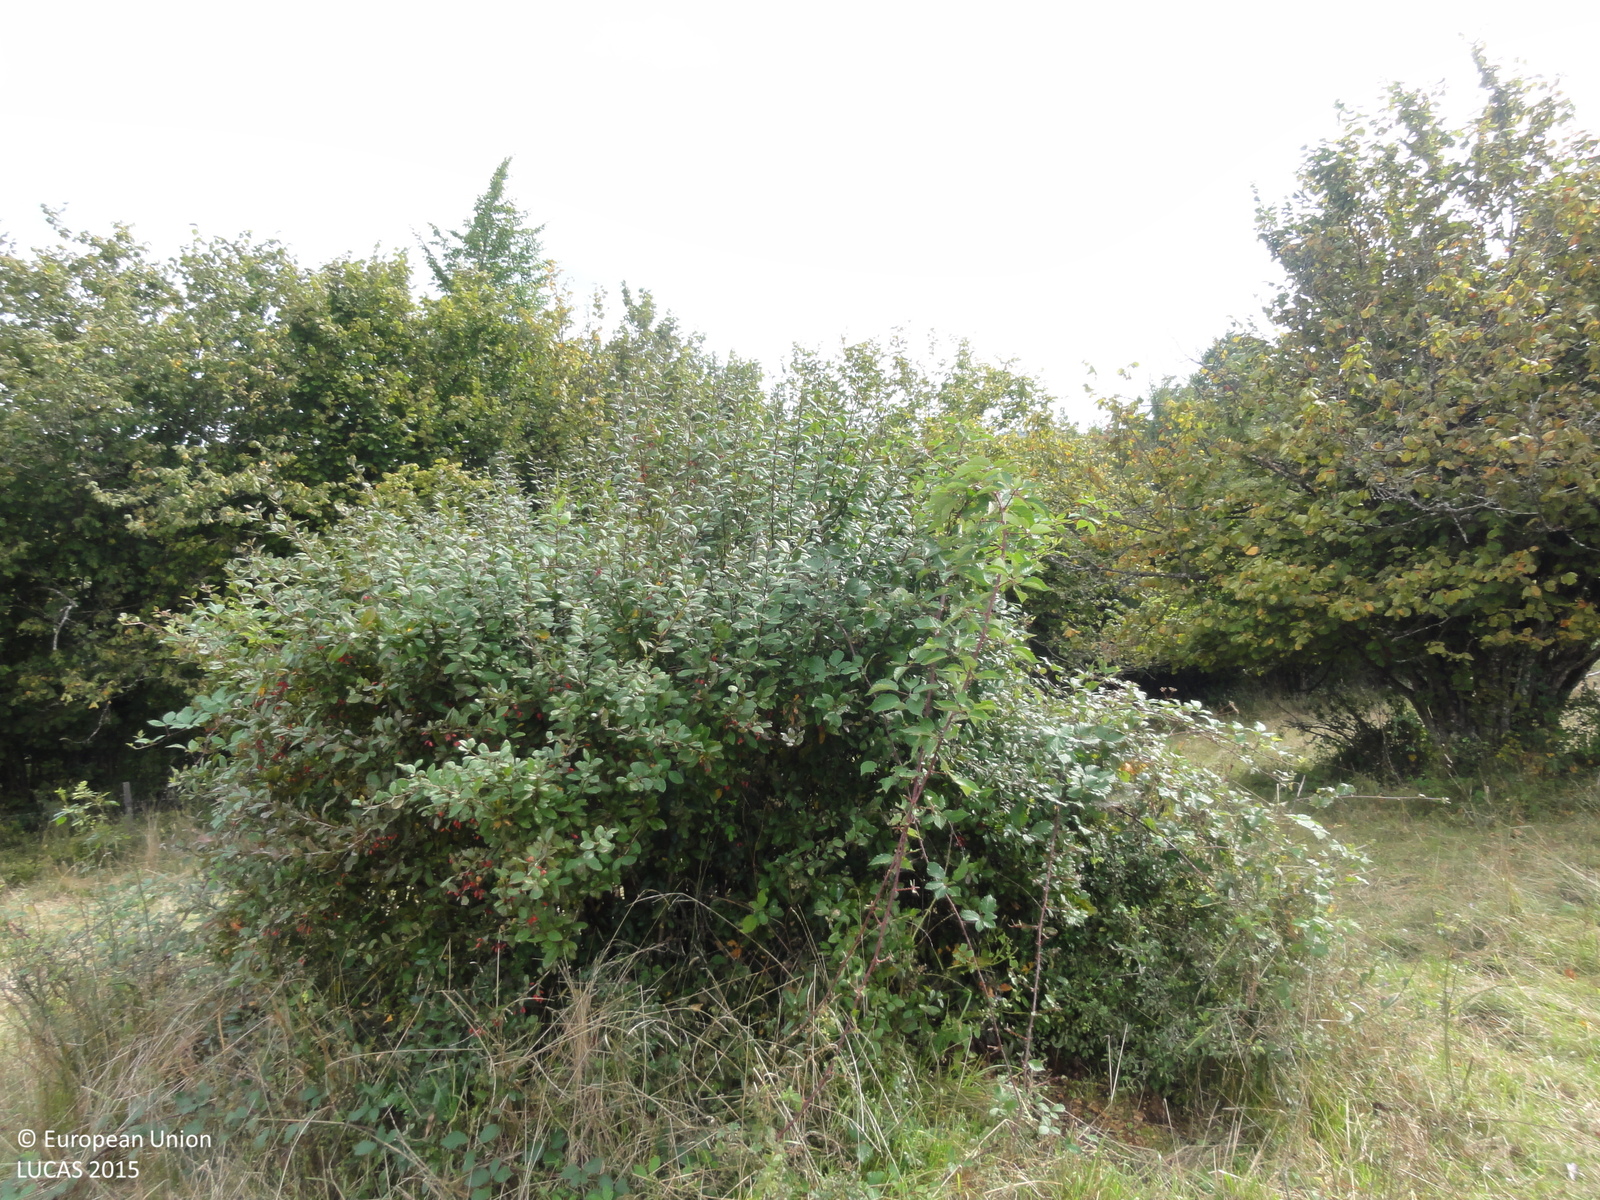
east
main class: Grassland
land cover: Grassland with sparse tree/shrub cover
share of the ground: > 75 %
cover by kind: herbaceous plants 90 %, broadleaved forest trees 5 %, shrubs 5 %
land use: Agriculture (excluding fallow land and kitchen gardens)
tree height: > 5 m
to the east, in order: Grassland with sparse tree/shrub cover; Fences; Broadleaved woodland; Grassland without tree/shrub cover; Broadleaved woodland; Grassland without tree/shrub cover
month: September
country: SI
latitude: 45.5830
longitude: 15.0328
